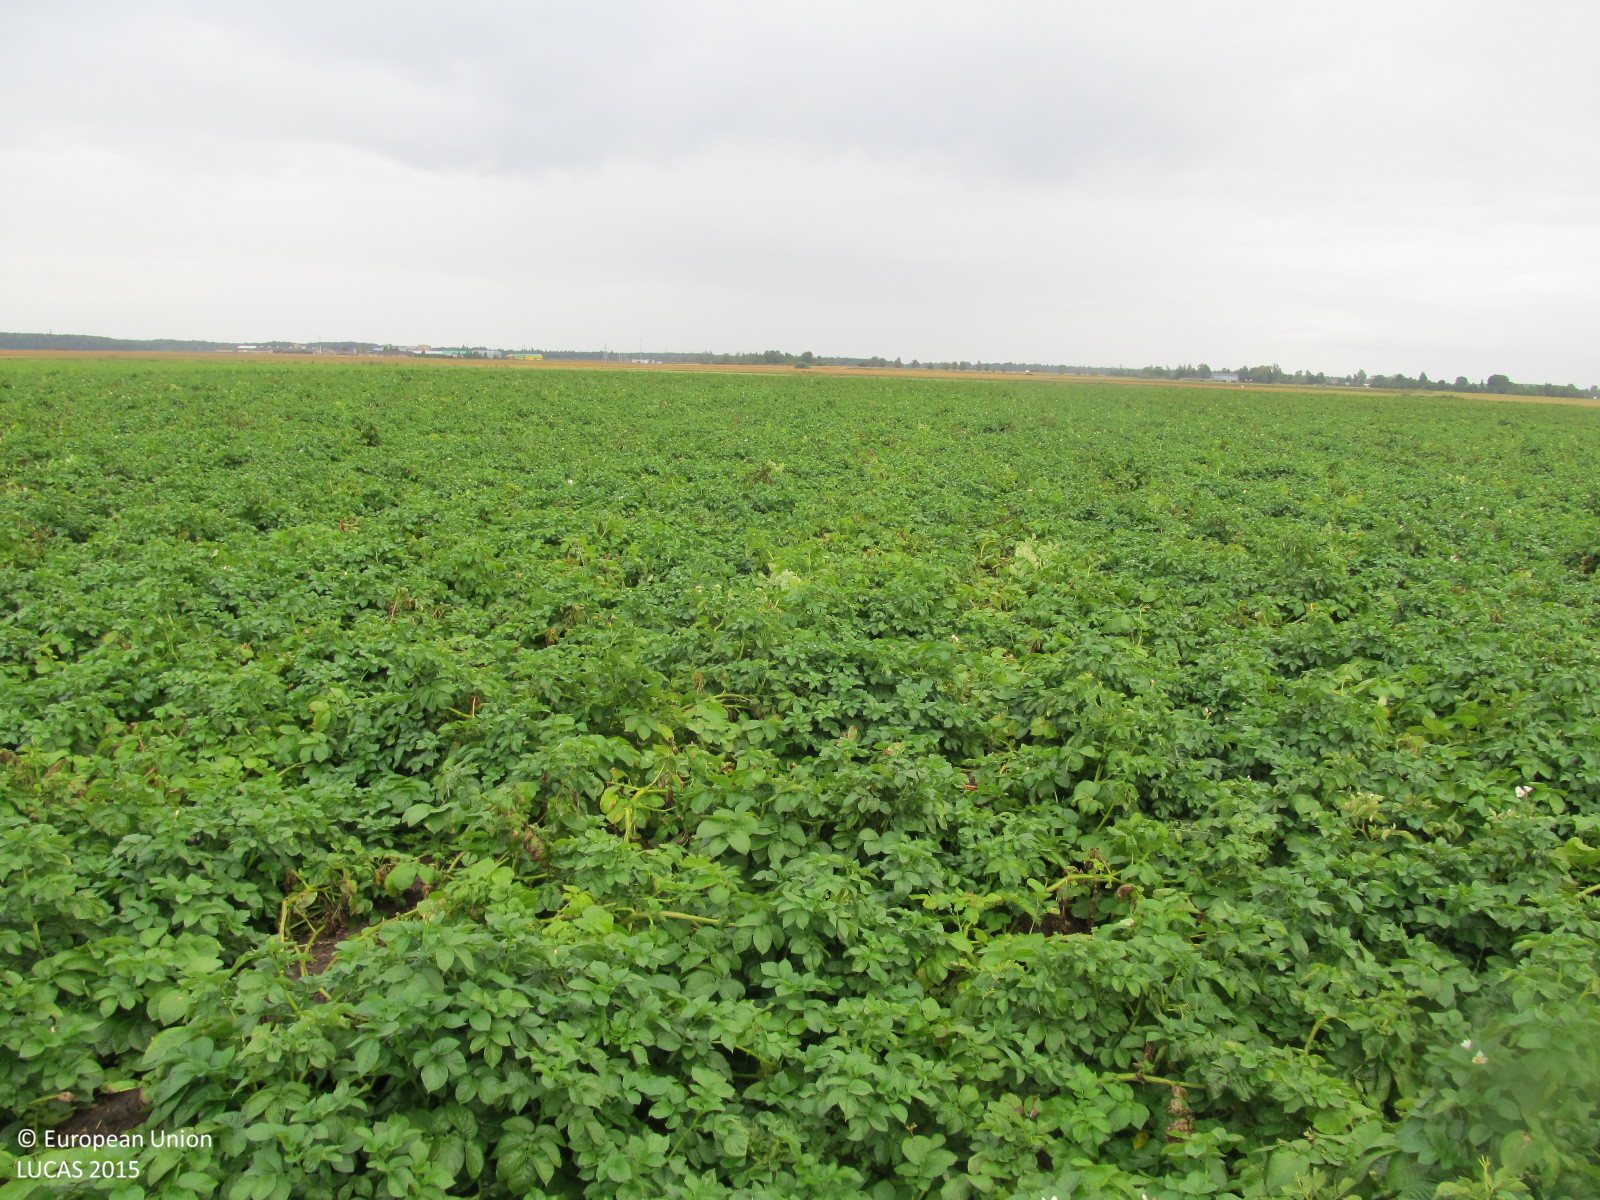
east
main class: Cropland
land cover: Potatoes
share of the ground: > 75 %
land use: Agriculture (excluding fallow land and kitchen gardens)
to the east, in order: Potatoes
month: September
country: LT
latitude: 56.1177
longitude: 23.2444
